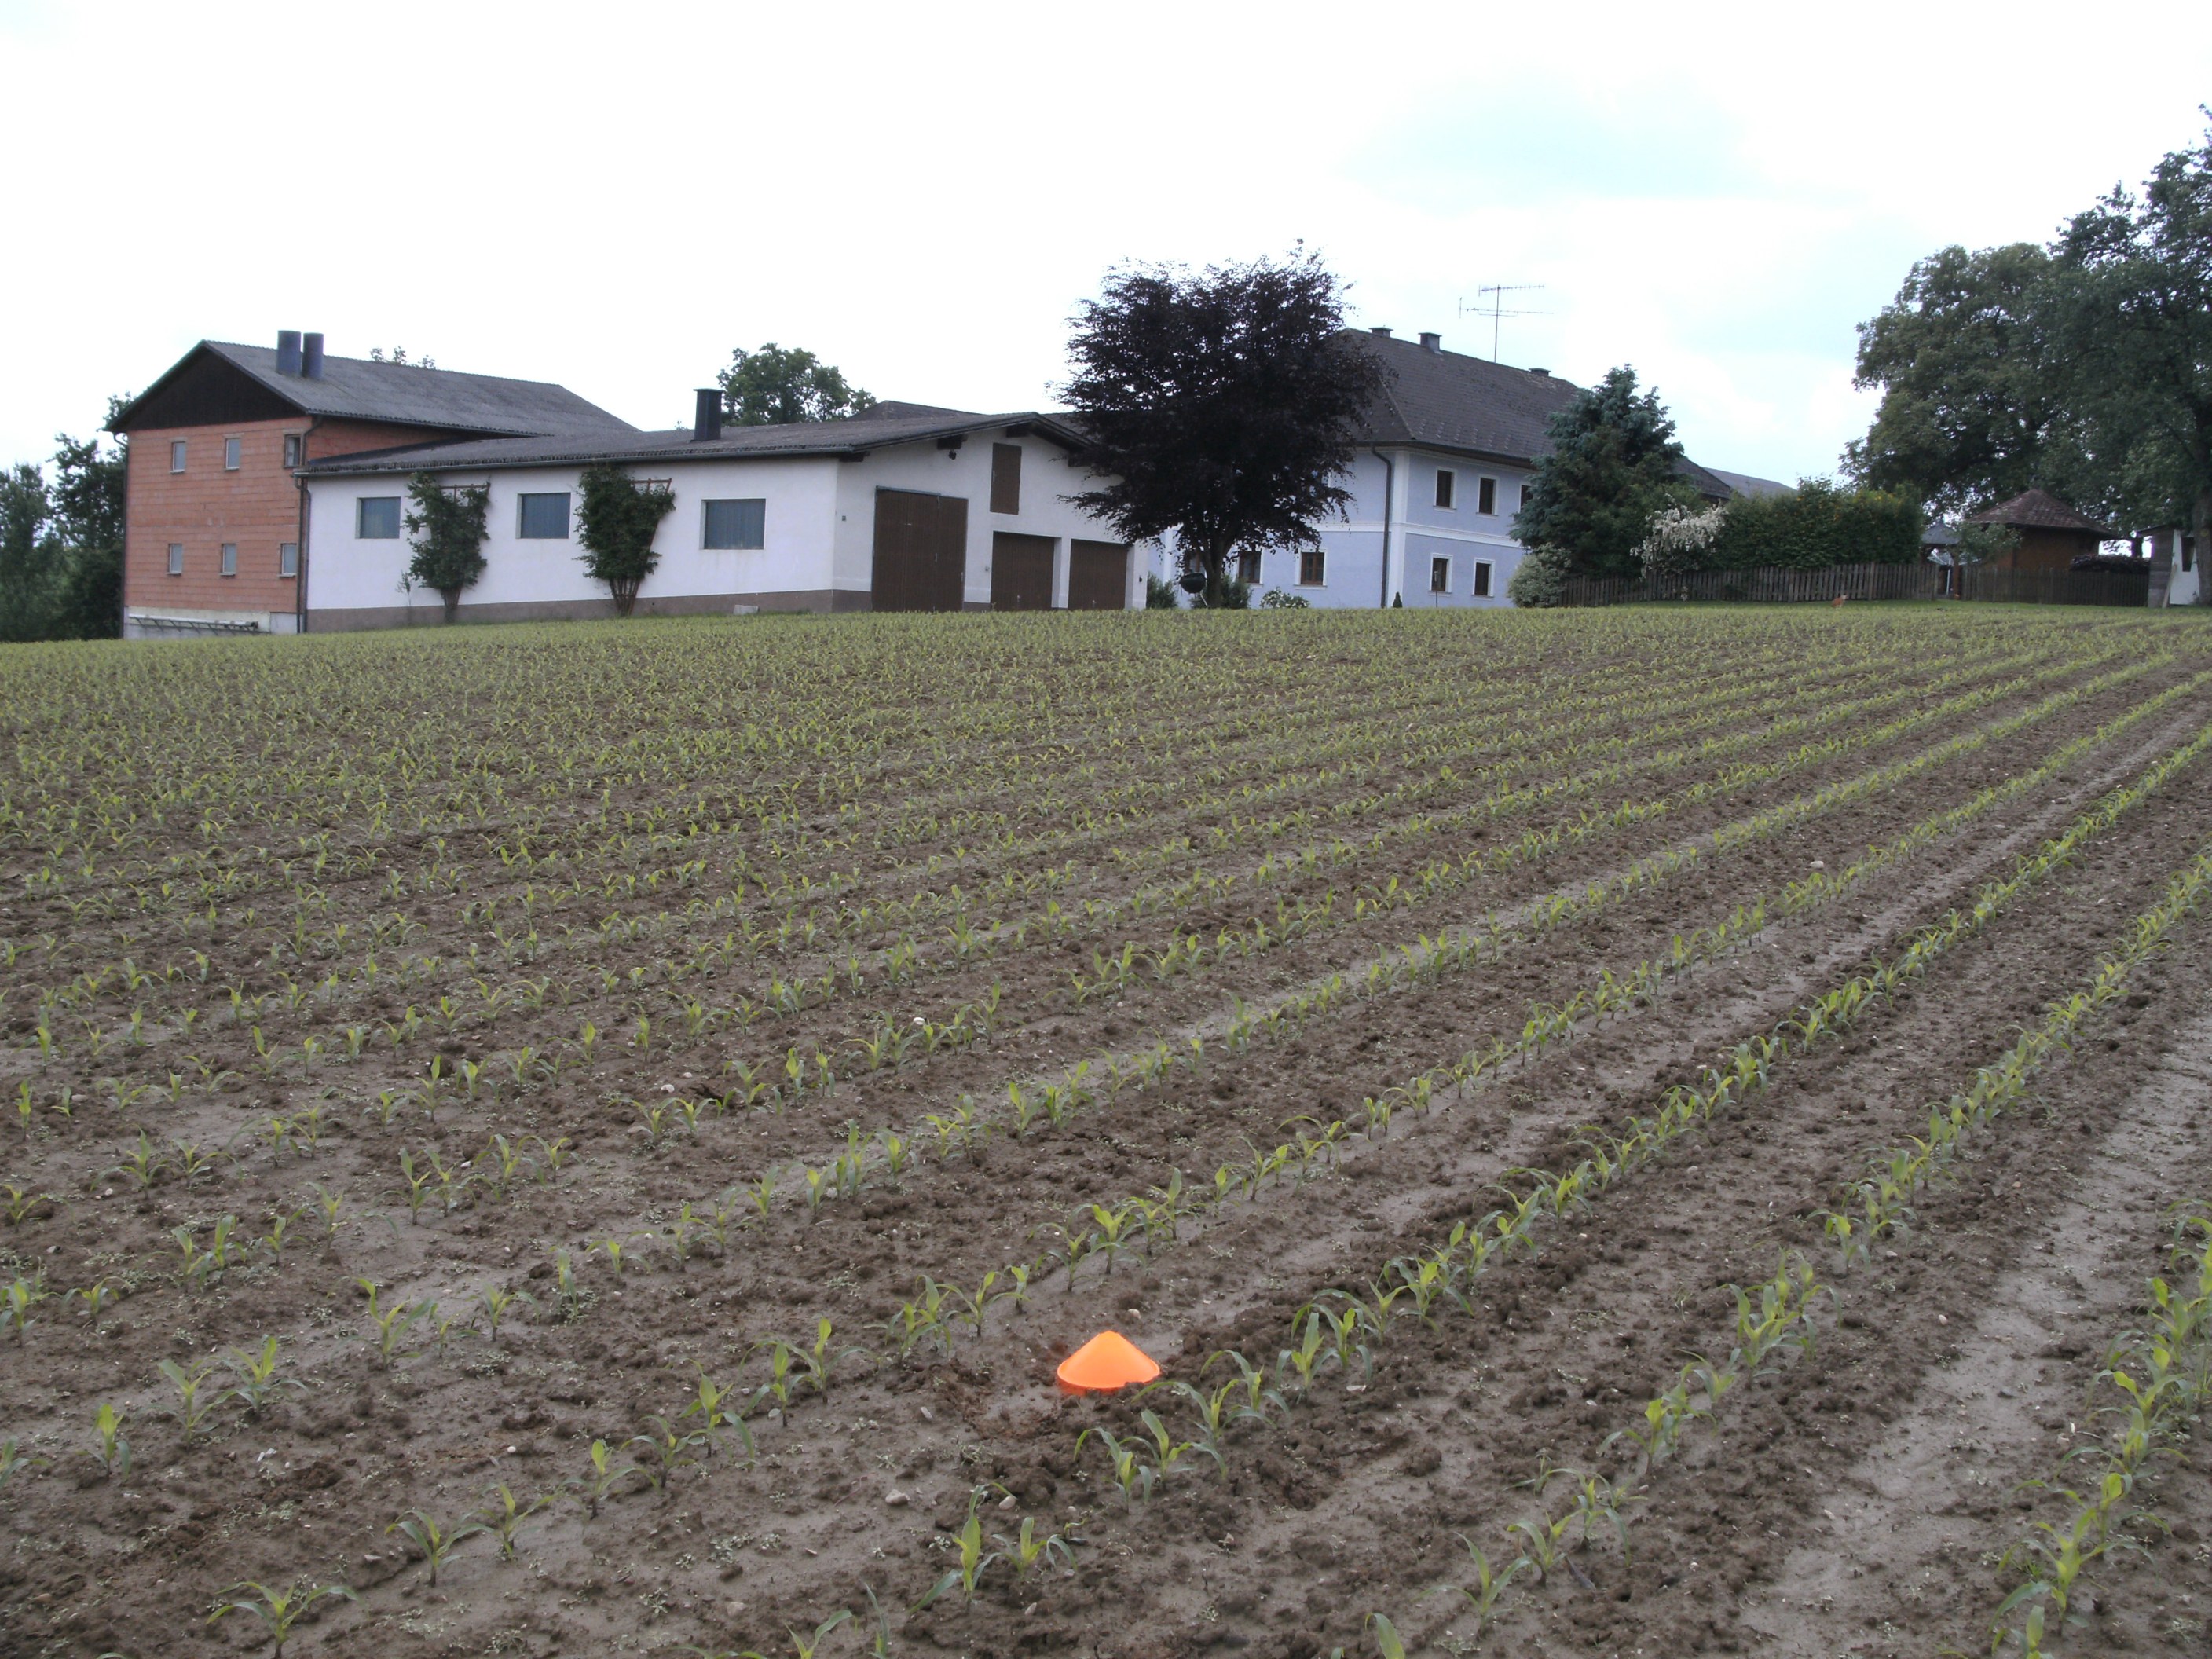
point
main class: Cropland
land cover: Maize
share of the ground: < 10 %
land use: Agriculture (excluding fallow land and kitchen gardens)
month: May
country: AT
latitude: 48.0964
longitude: 14.0144
